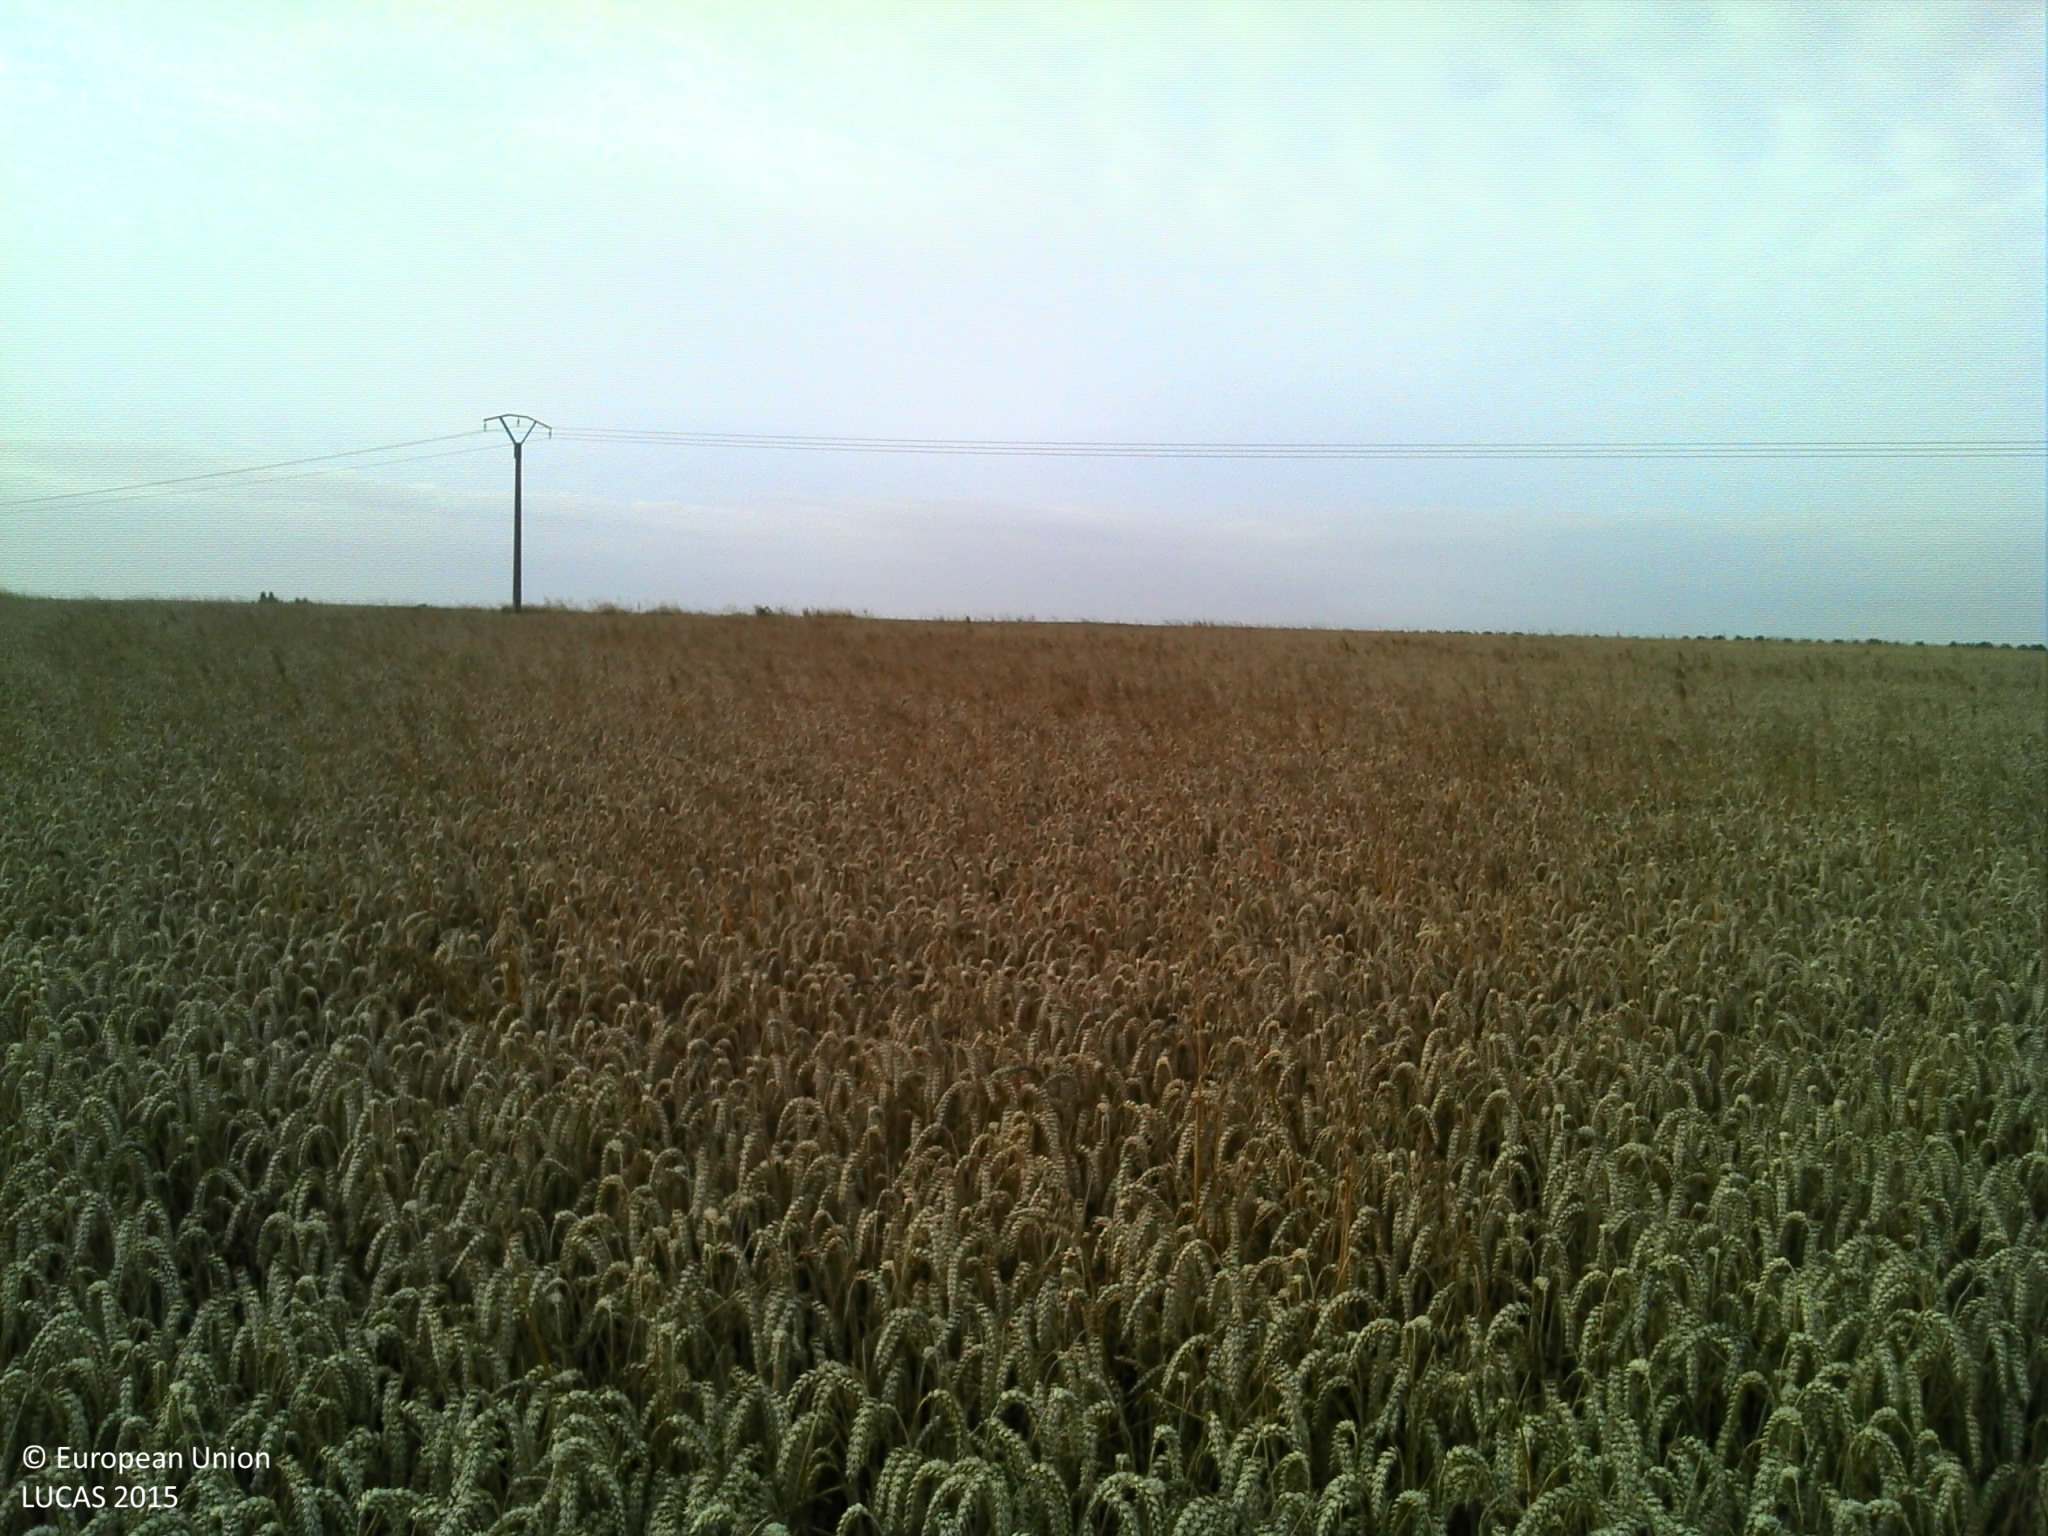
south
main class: Cropland
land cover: Common wheat
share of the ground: > 75 %
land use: Agriculture (excluding fallow land and kitchen gardens)
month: July
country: FR
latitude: 49.1971
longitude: -0.2298
